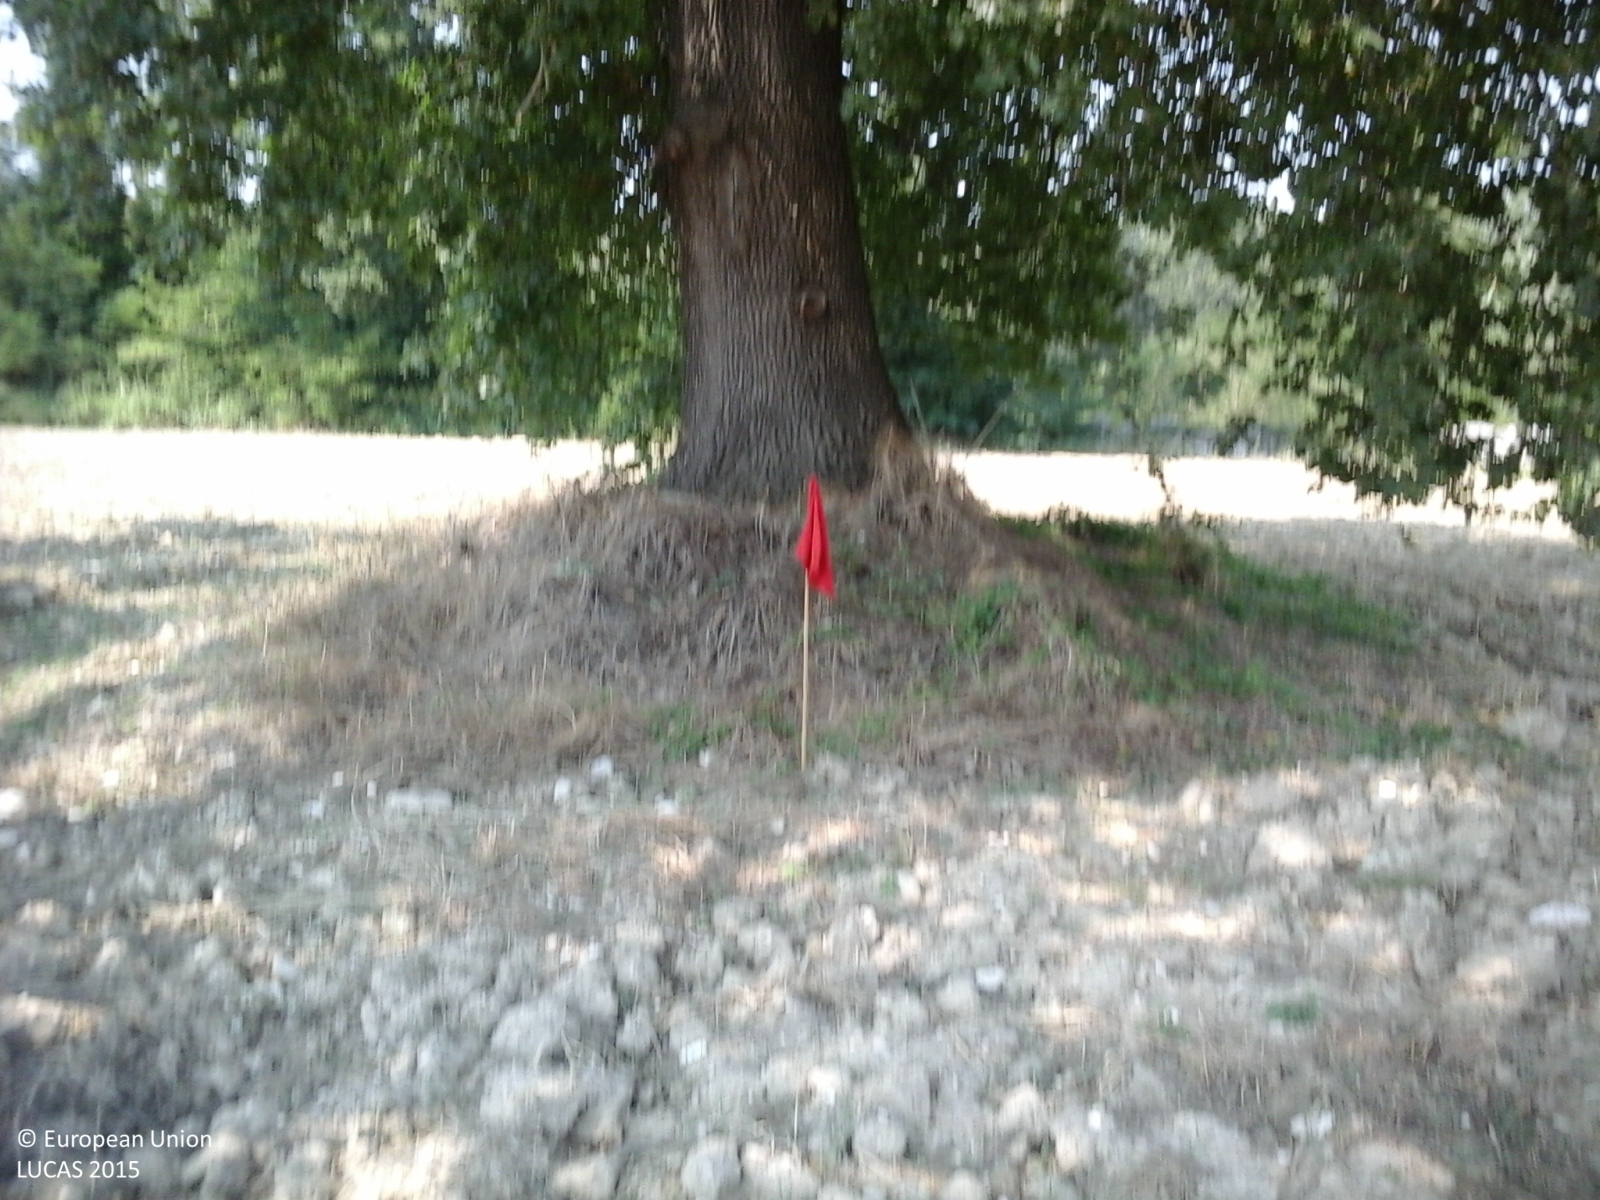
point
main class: Woodland
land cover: Broadleaved woodland
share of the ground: 10 - 25 %
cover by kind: broadleaved forest trees 100 %
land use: Forestry
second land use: Agriculture (excluding fallow land and kitchen gardens)
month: August
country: IT
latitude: 43.0646
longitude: 13.4657
